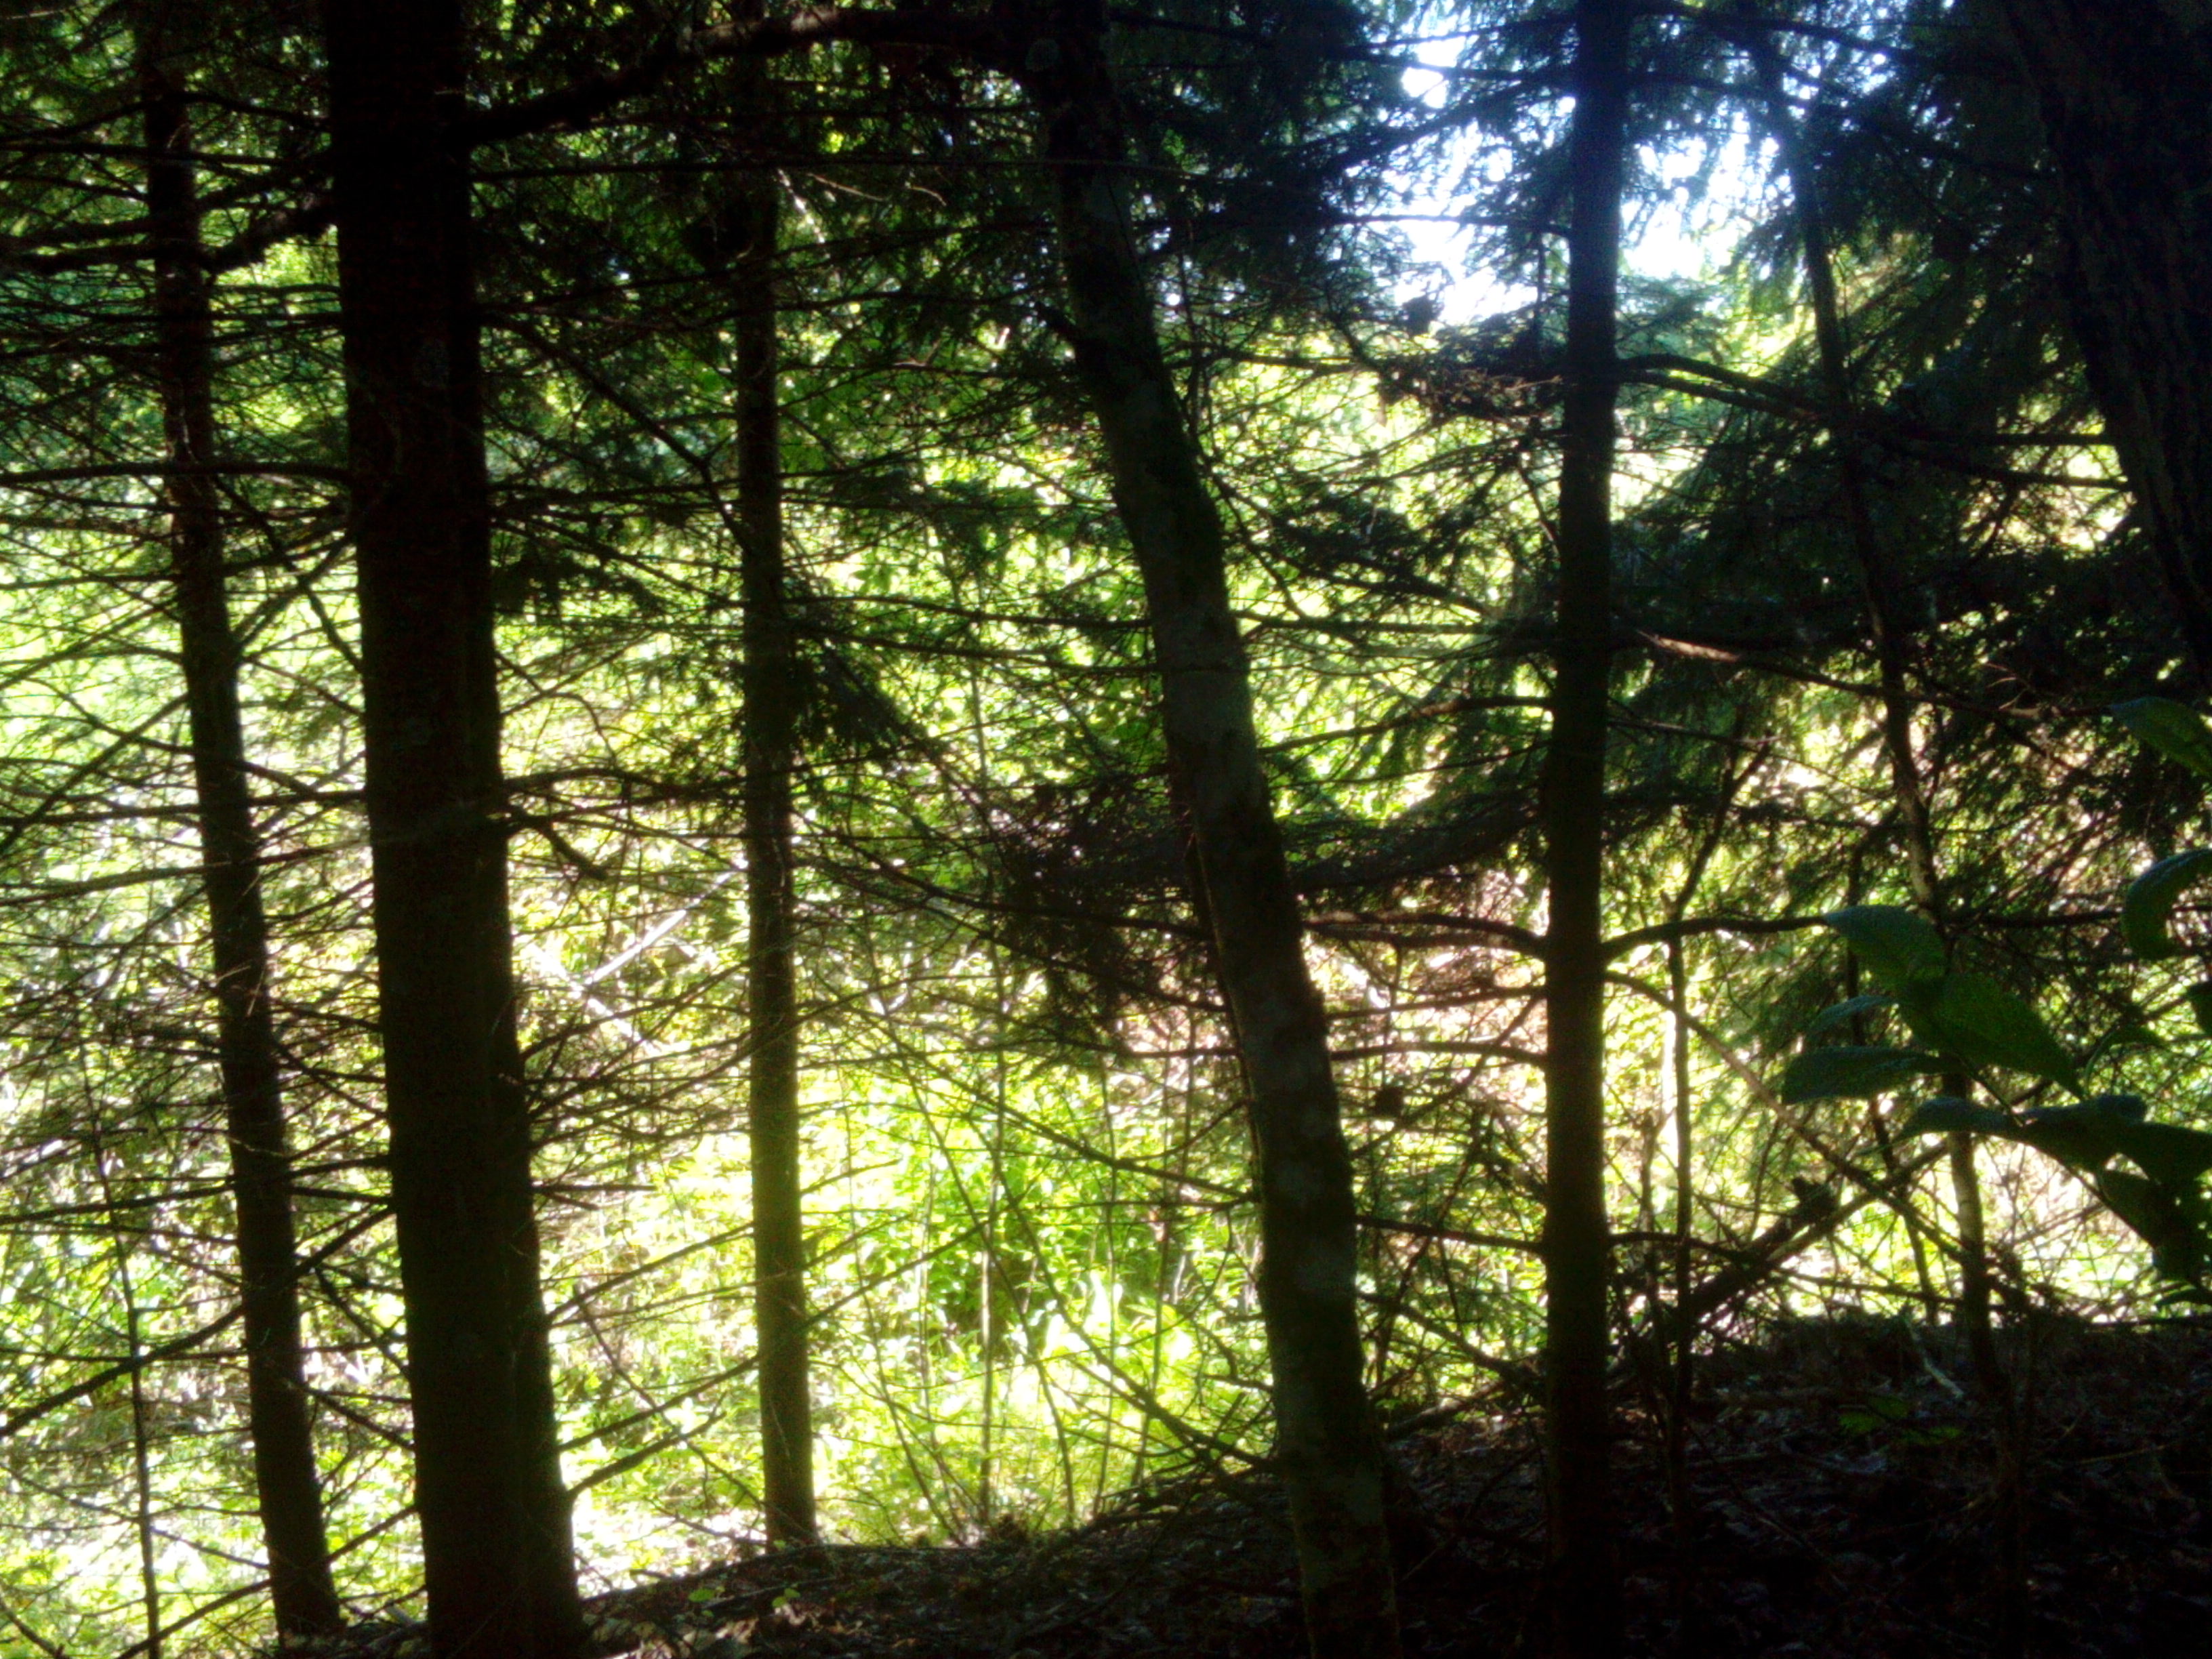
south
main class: Woodland
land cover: Spruce dominated mixed woodland
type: hemiboreal forest and nemoral coniferous forest and mixed broadleaved-coniferous forest
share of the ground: > 75 %
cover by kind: broadleaved forest trees 55 %, coniferous forest trees 40 %, shrubs 5 %
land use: Forestry
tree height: > 5 m
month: June
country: LV
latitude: 56.6710
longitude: 21.8781
